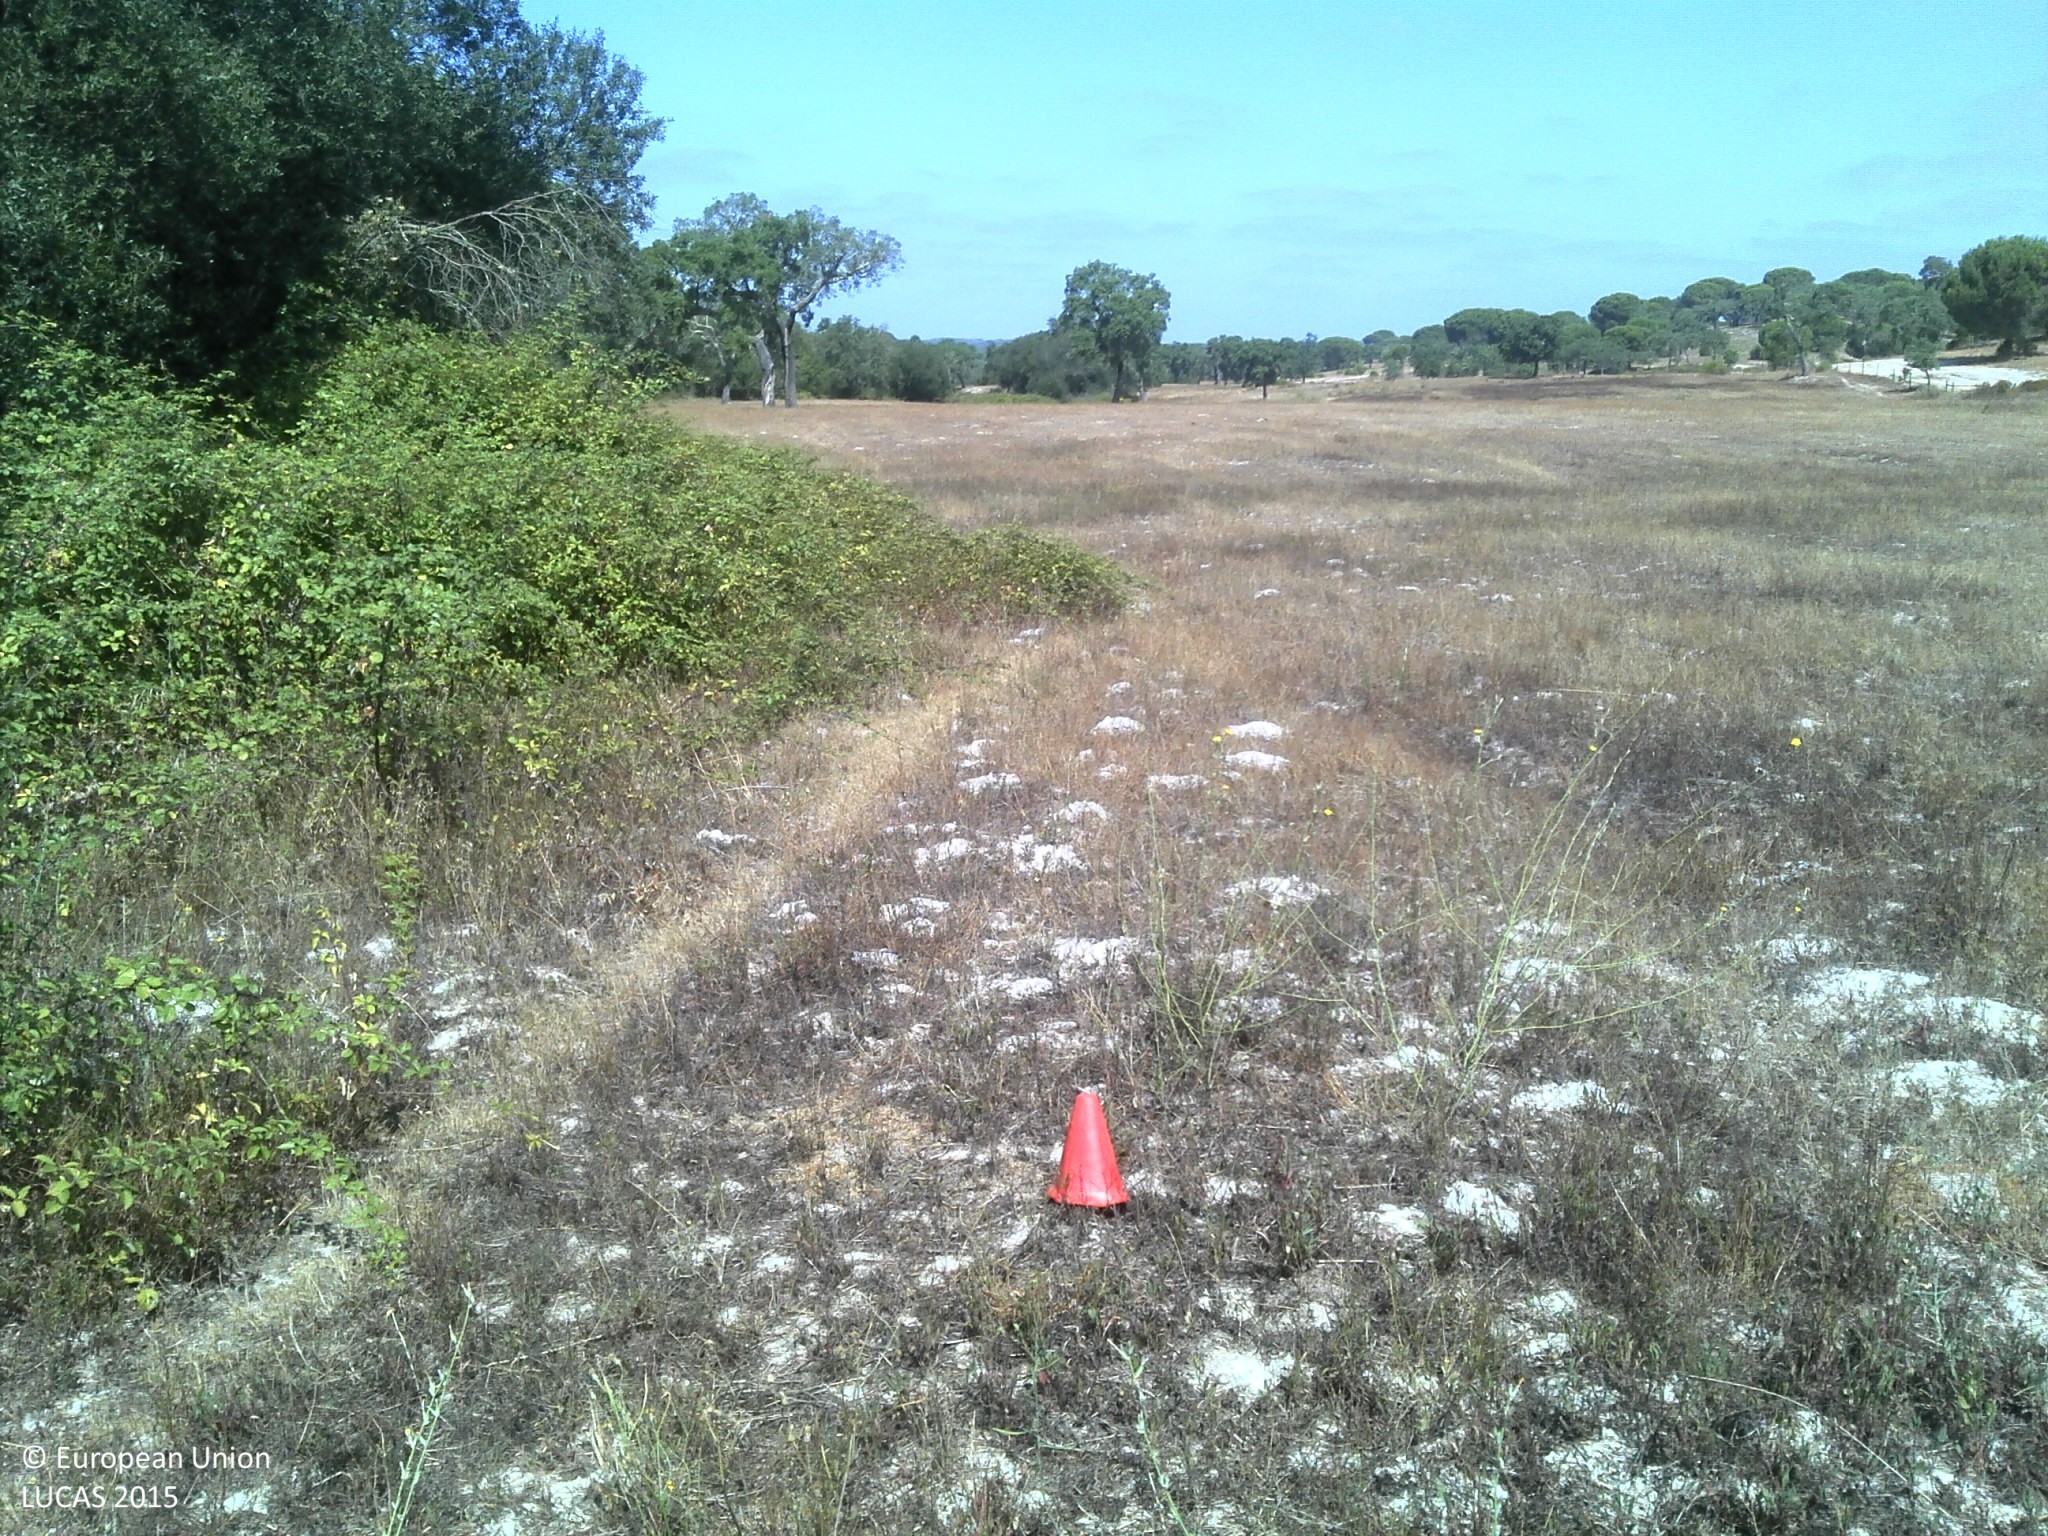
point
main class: Grassland
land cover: Grassland without tree/shrub cover
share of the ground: 25 - 50 %
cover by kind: unconsolidated bare surface 60 %, herbaceous plants 40 %
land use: Agriculture (excluding fallow land and kitchen gardens)
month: July
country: PT
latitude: 39.0643
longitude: -8.3078
